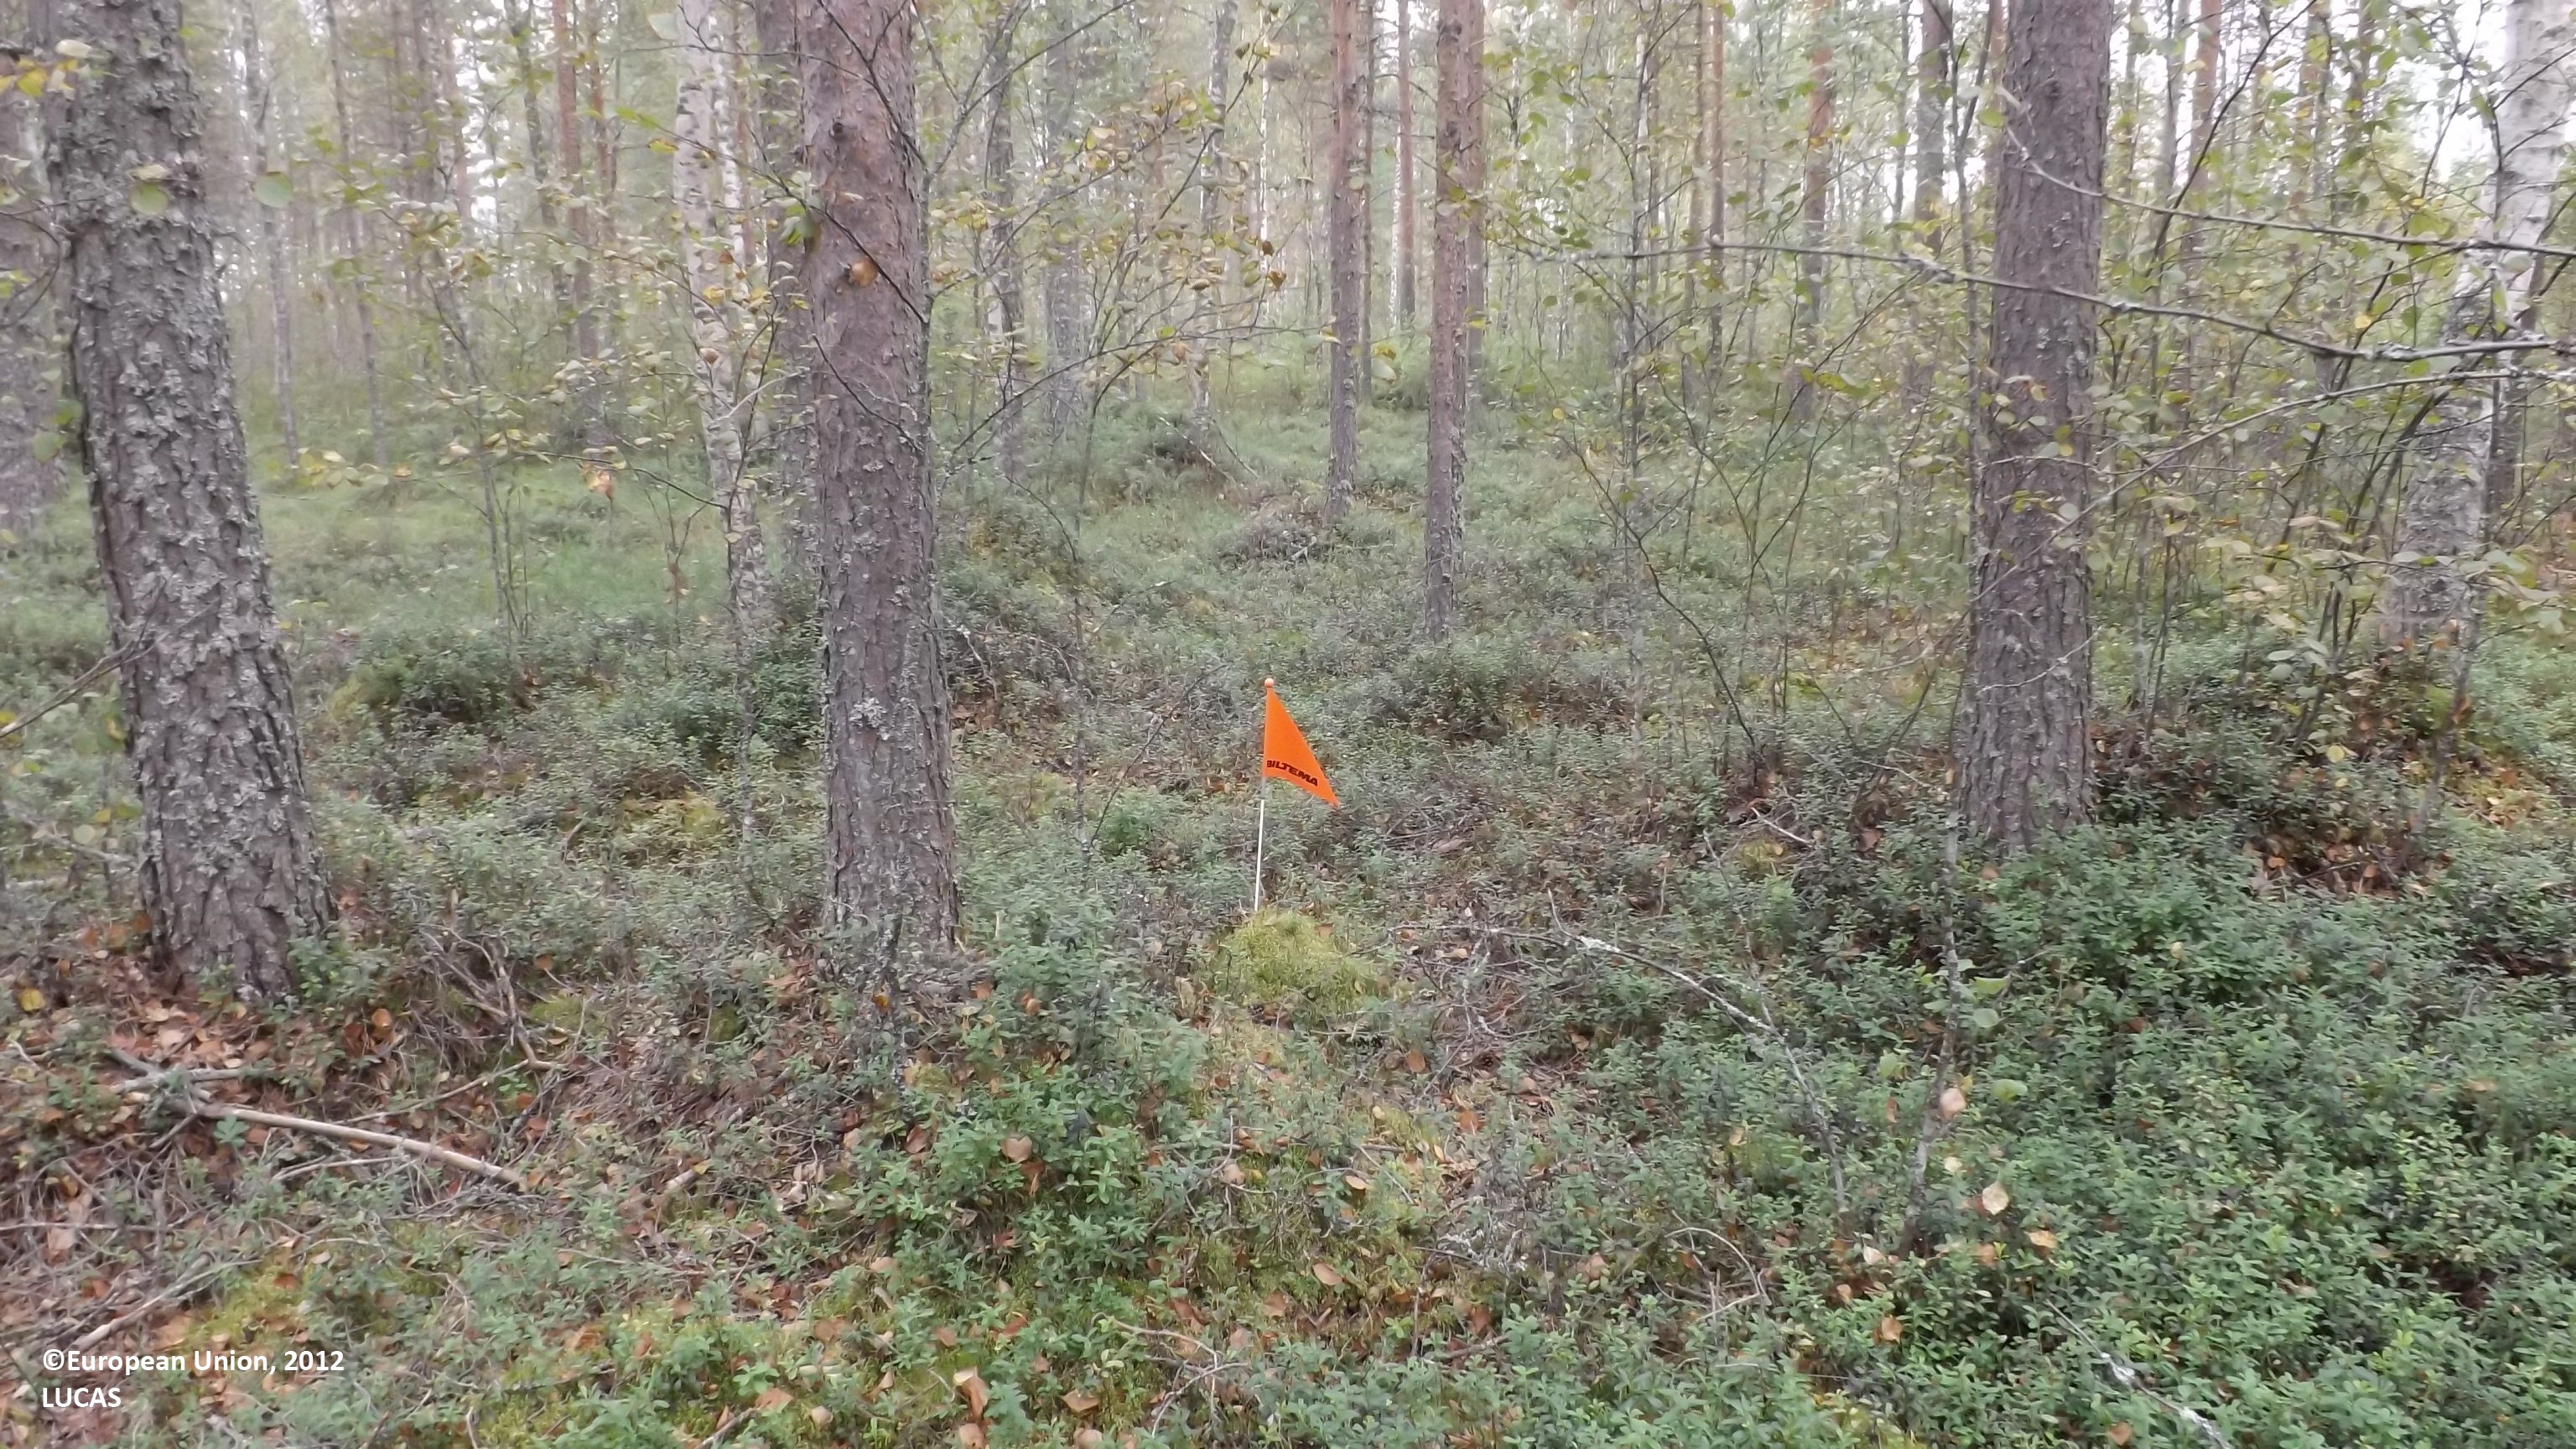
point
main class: Woodland
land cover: Pine dominated mixed woodland
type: boreal forest
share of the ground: > 75 %
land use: Forestry
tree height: > 5 m
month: August
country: FI
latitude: 63.8758
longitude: 23.8861
